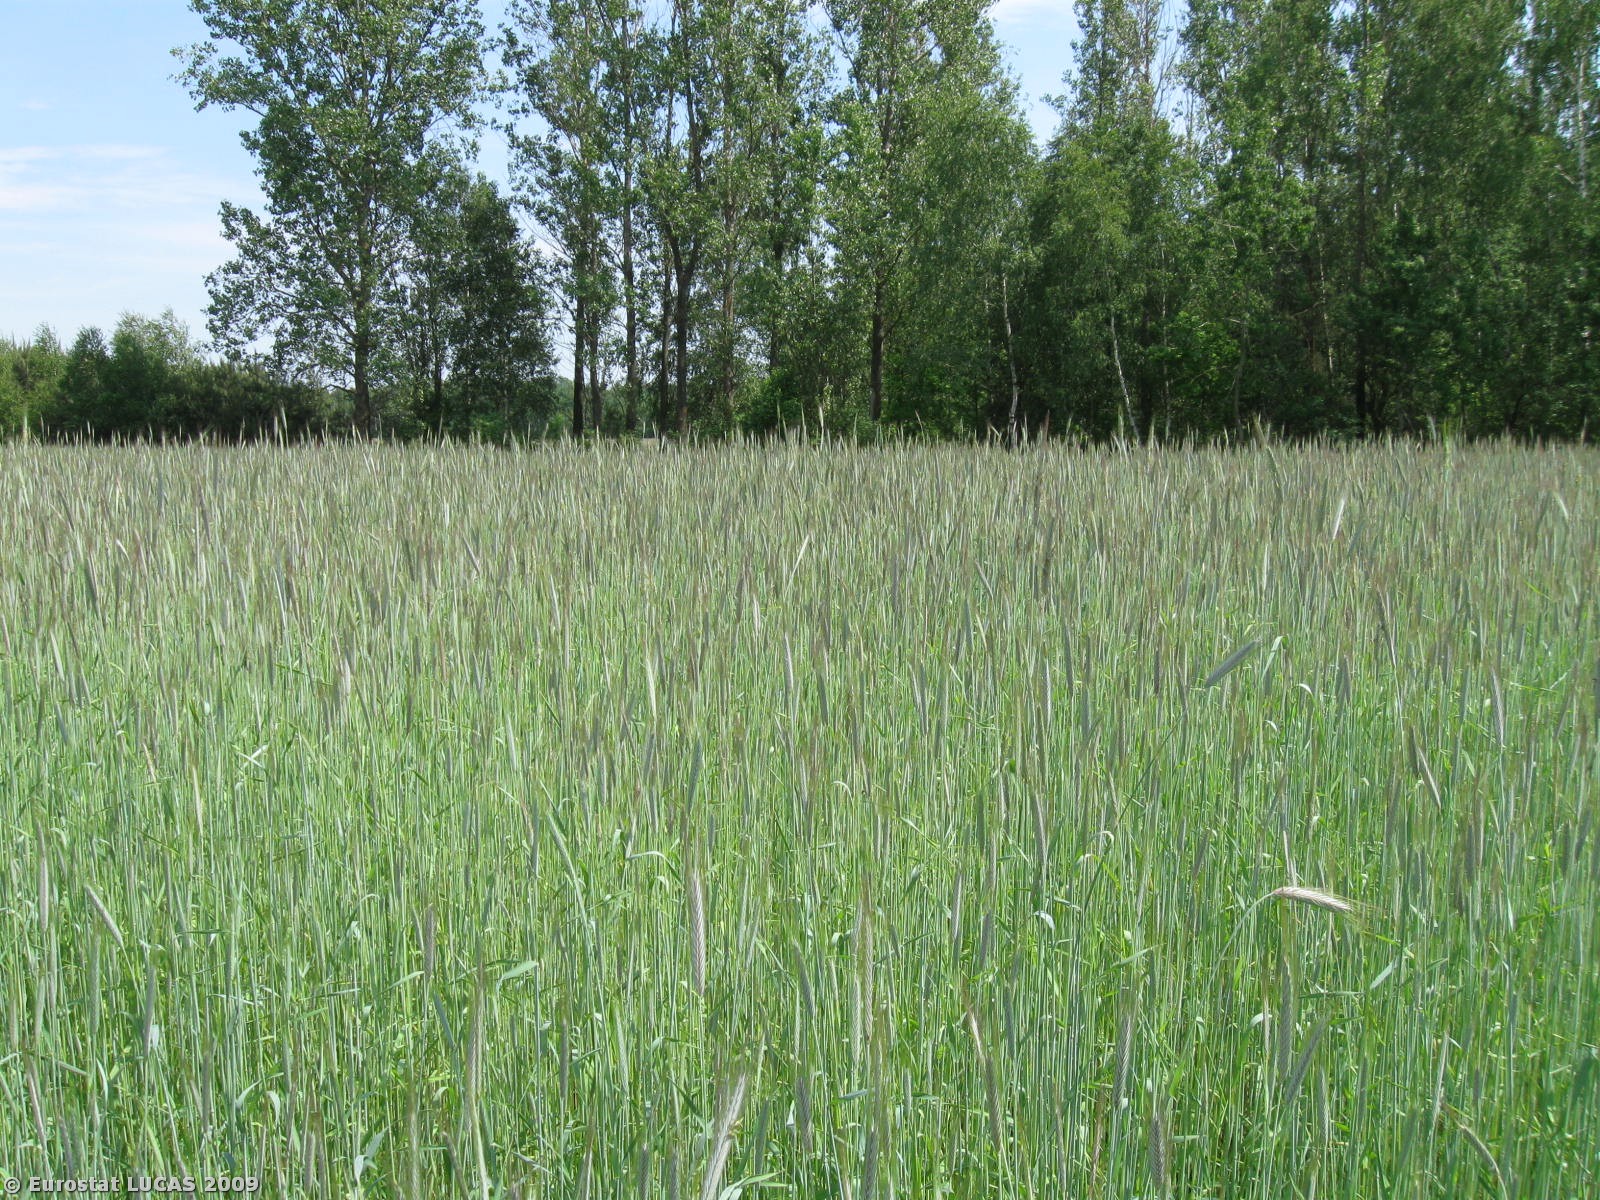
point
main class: Cropland
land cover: Rye
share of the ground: > 75 %
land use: Agriculture (excluding fallow land and kitchen gardens)
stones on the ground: < 10 %
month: May
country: PL
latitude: 50.6498
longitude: 20.4040
